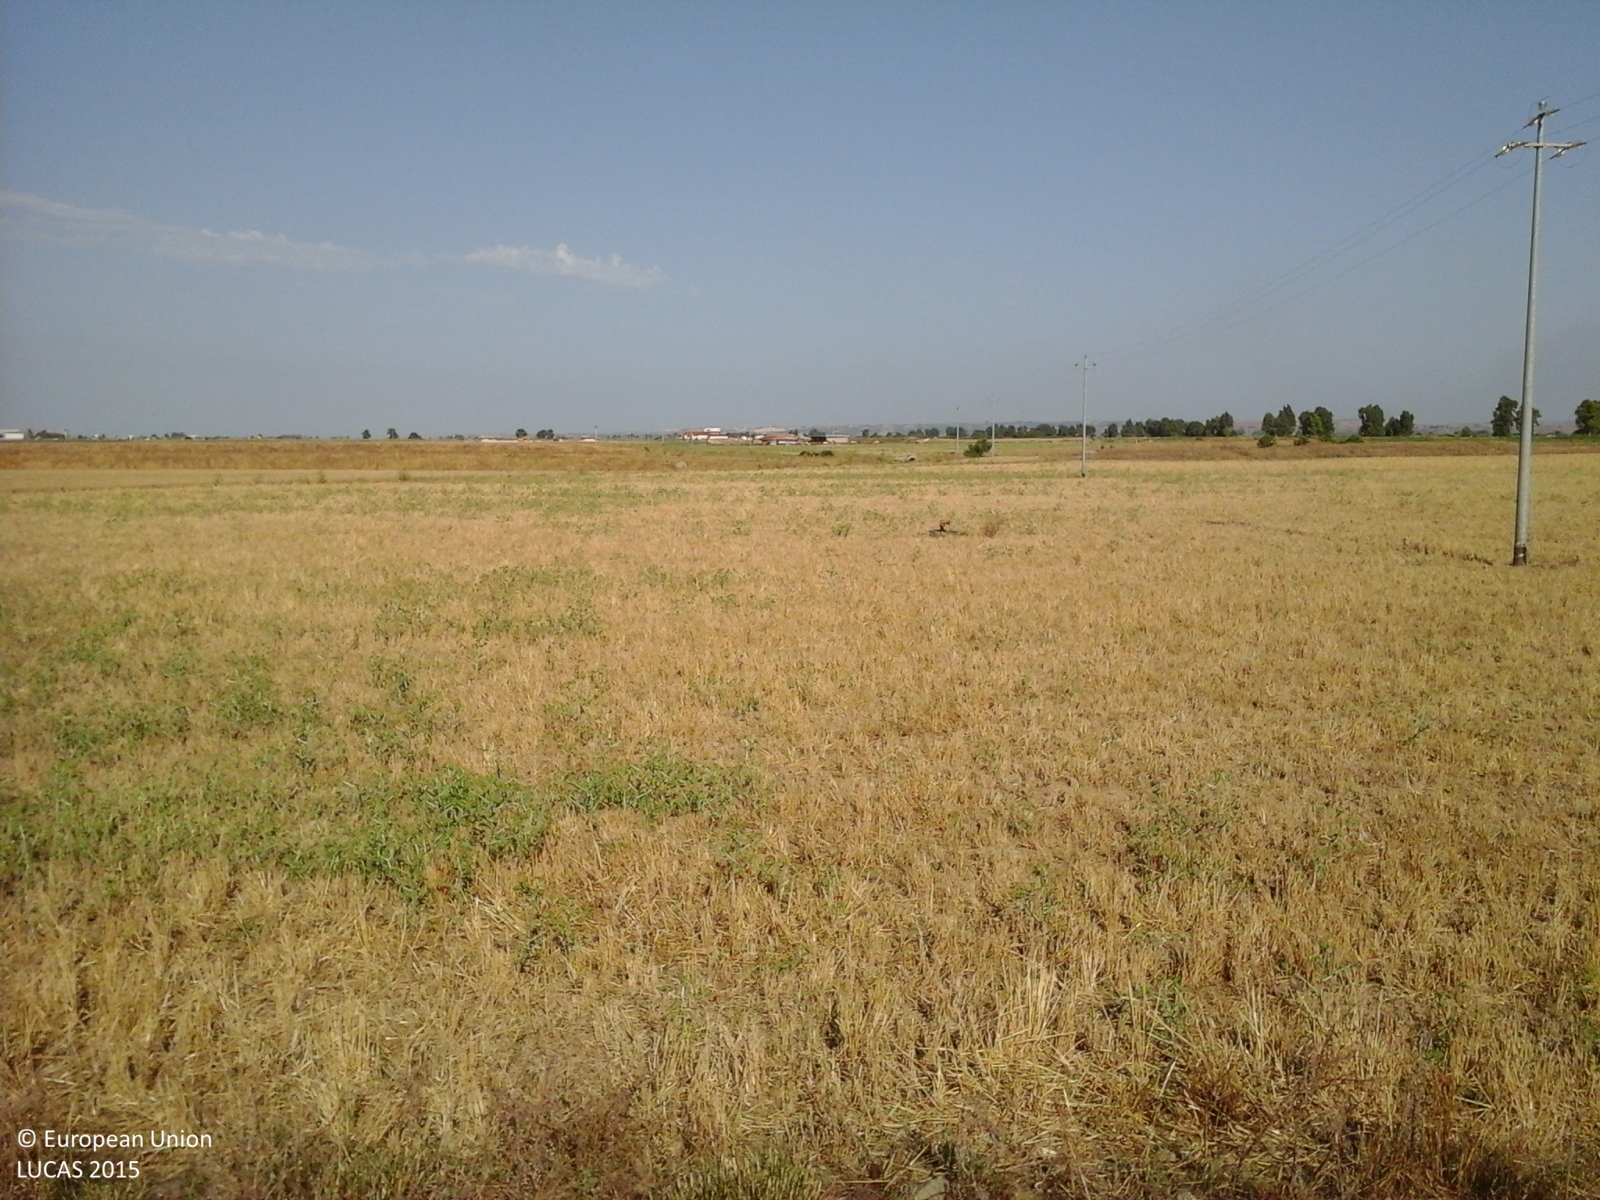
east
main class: Grassland
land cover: Spontaneously vegetated surfaces
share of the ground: > 75 %
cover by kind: herbaceous plants 100 %
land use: Community services
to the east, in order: Spontaneously vegetated surfaces
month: June
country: IT
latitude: 37.4041
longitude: 14.8784
